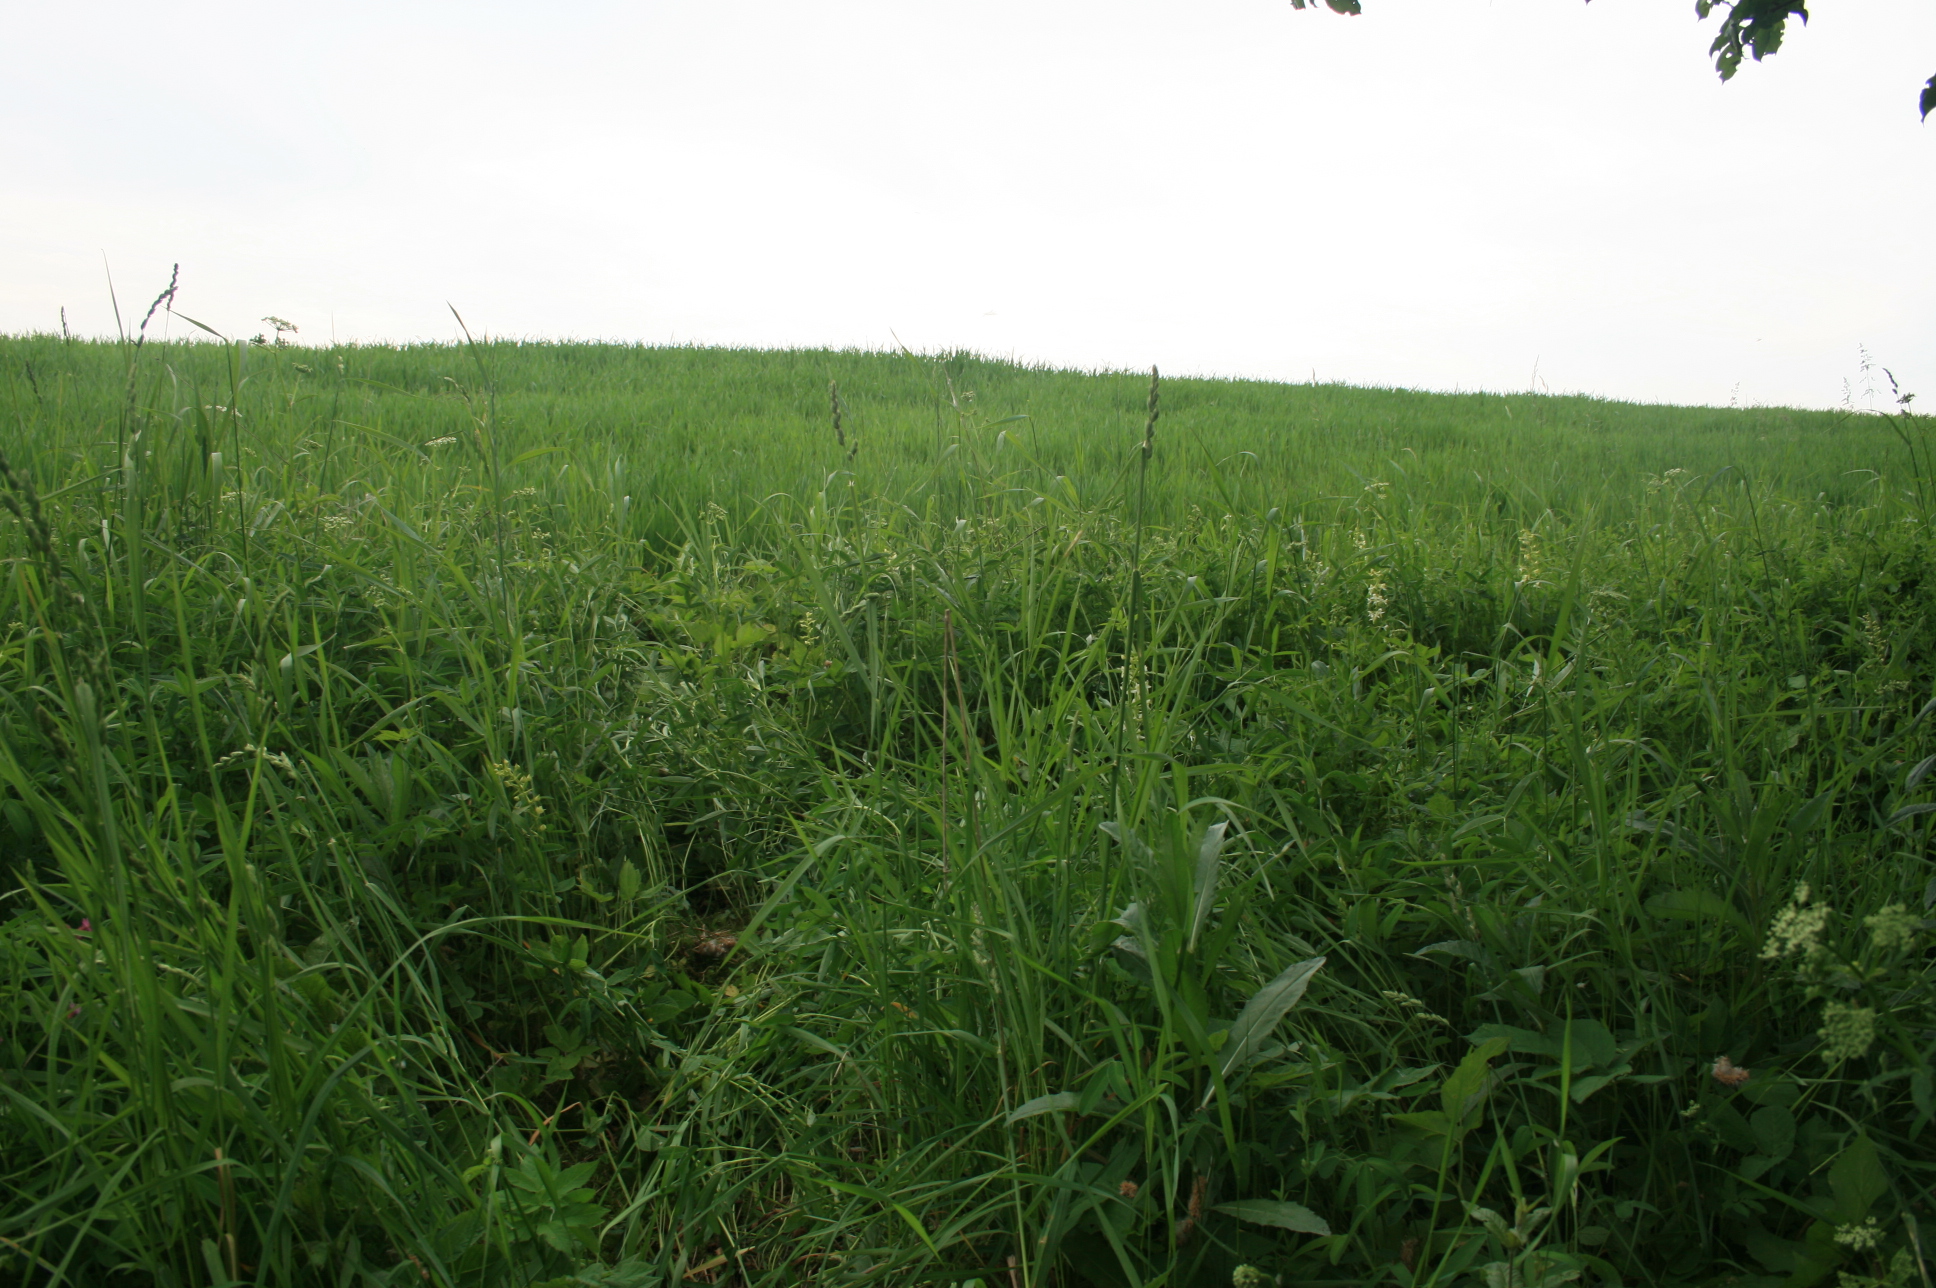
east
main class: Woodland
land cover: Broadleaved woodland
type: non-riverine alder, birch or aspen forest
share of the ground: > 75 %
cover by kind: broadleaved forest trees 90 %, herbaceous plants 10 %
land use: Semi-natural and natural areas not in use
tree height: > 5 m
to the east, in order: Broadleaved woodland; Common wheat; Spontaneously vegetated surfaces; Shrubland with sparse tree cover; Broadleaved woodland
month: June
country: LT
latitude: 55.7062
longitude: 22.2625
